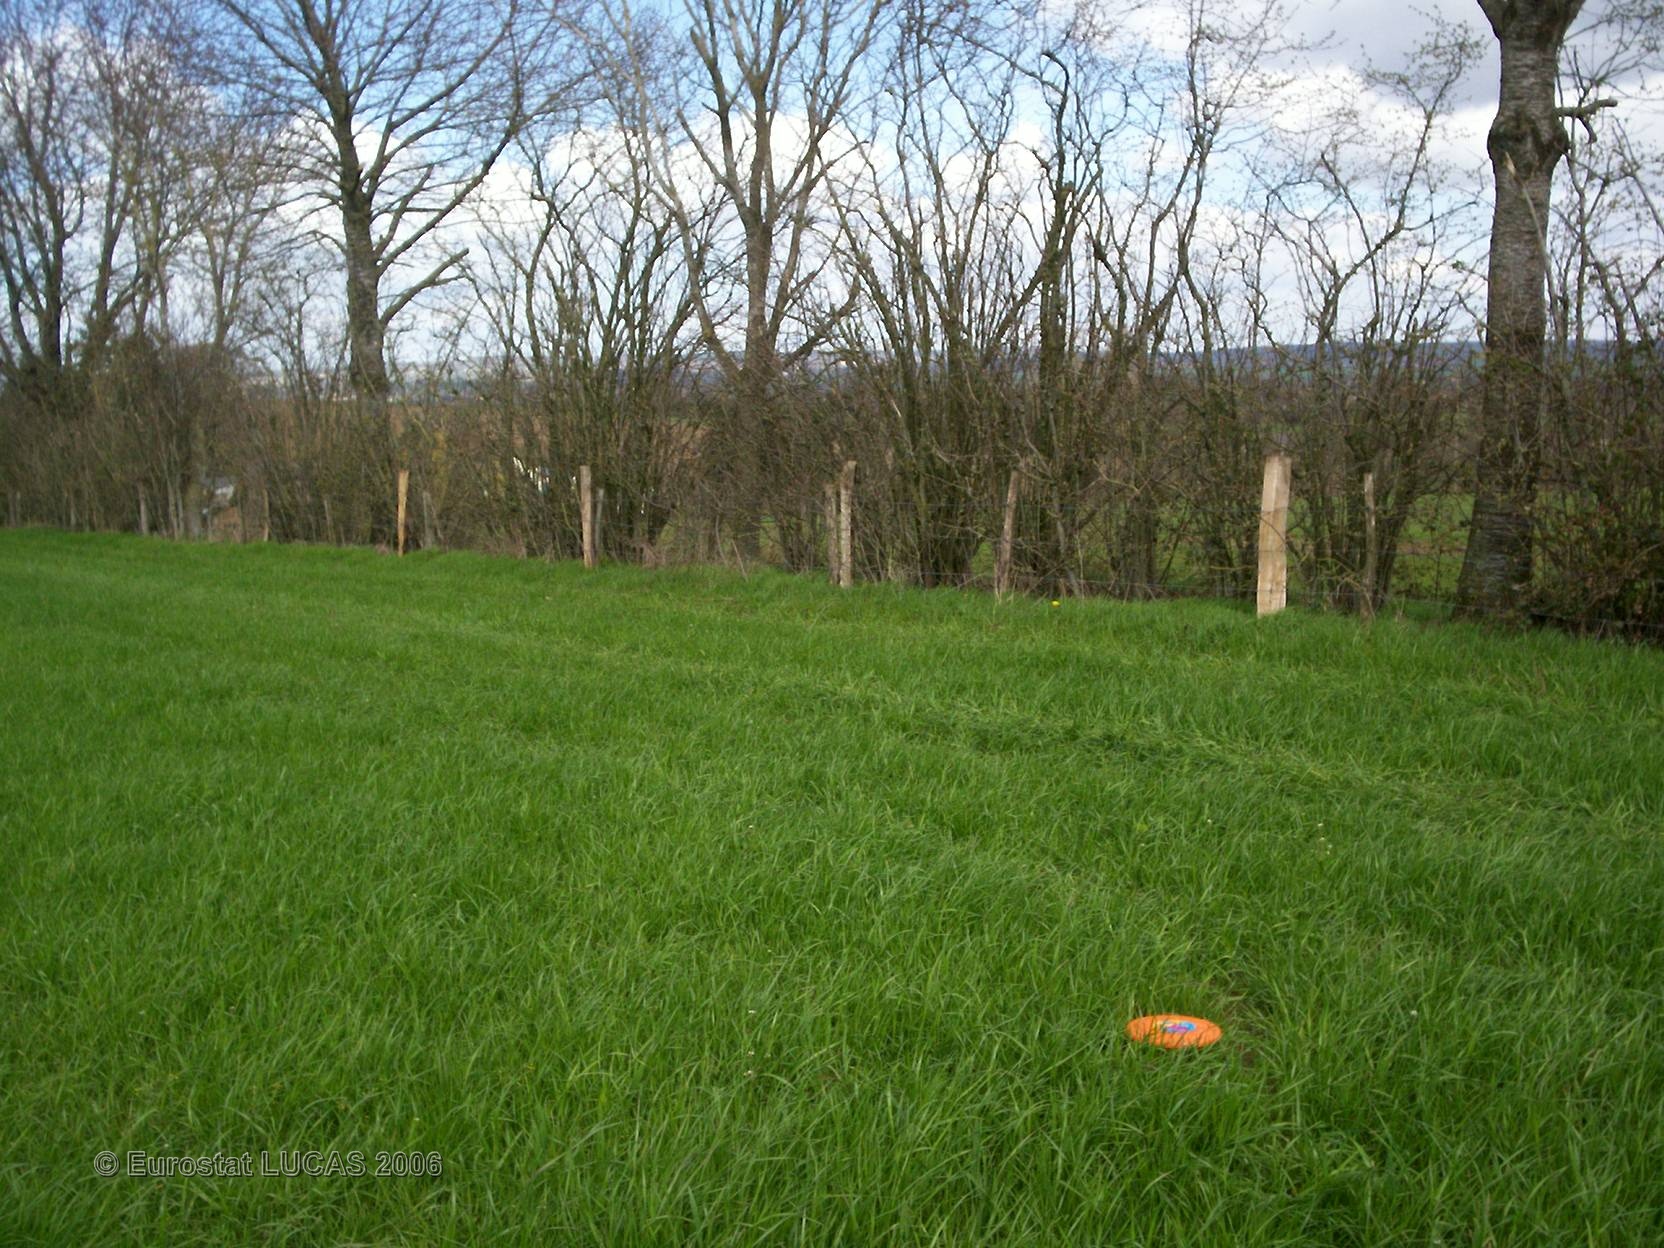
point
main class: Grassland
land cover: Grassland without tree/shrub cover
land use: Agriculture (excluding fallow land and kitchen gardens)
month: April
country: FR
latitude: 48.3054
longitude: -0.2647
